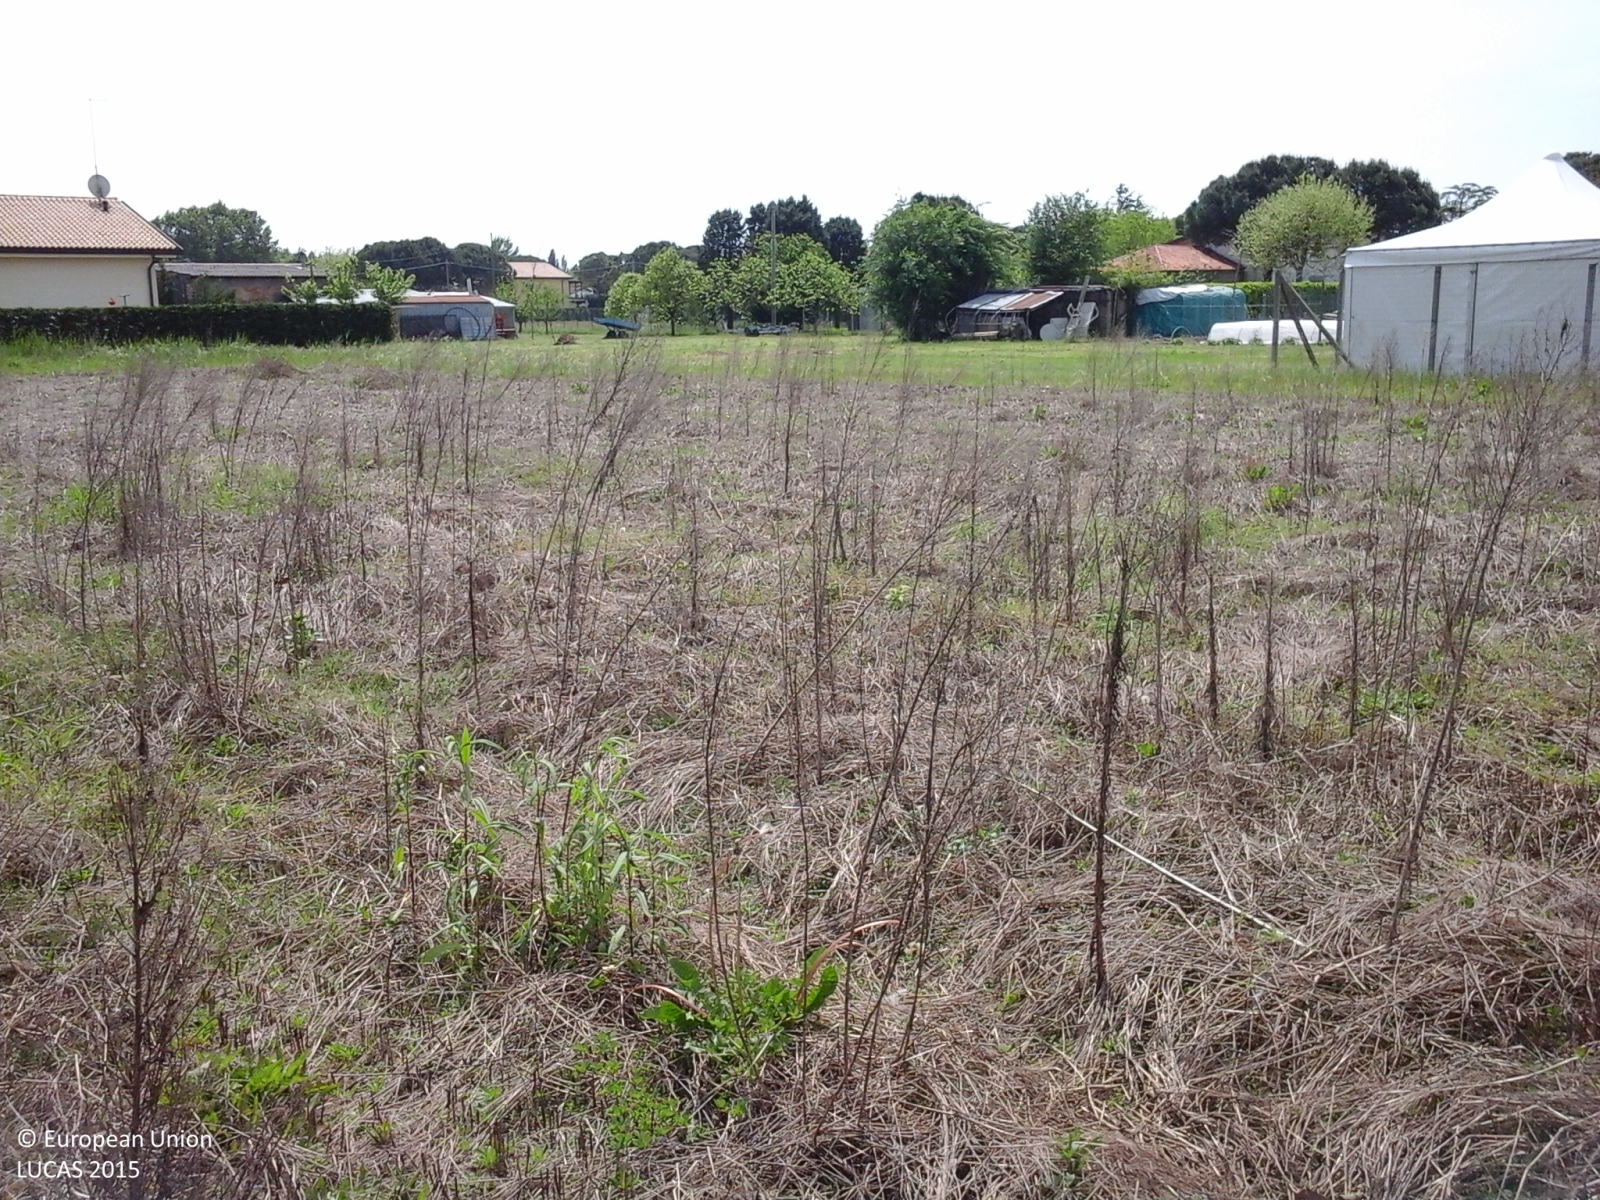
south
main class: Grassland
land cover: Spontaneously vegetated surfaces
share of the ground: 50 - 75 %
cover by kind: herbaceous plants 75 %, consolidated bare surface 25 %
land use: Fallow land
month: May
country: IT
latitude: 45.4402
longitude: 12.4380
